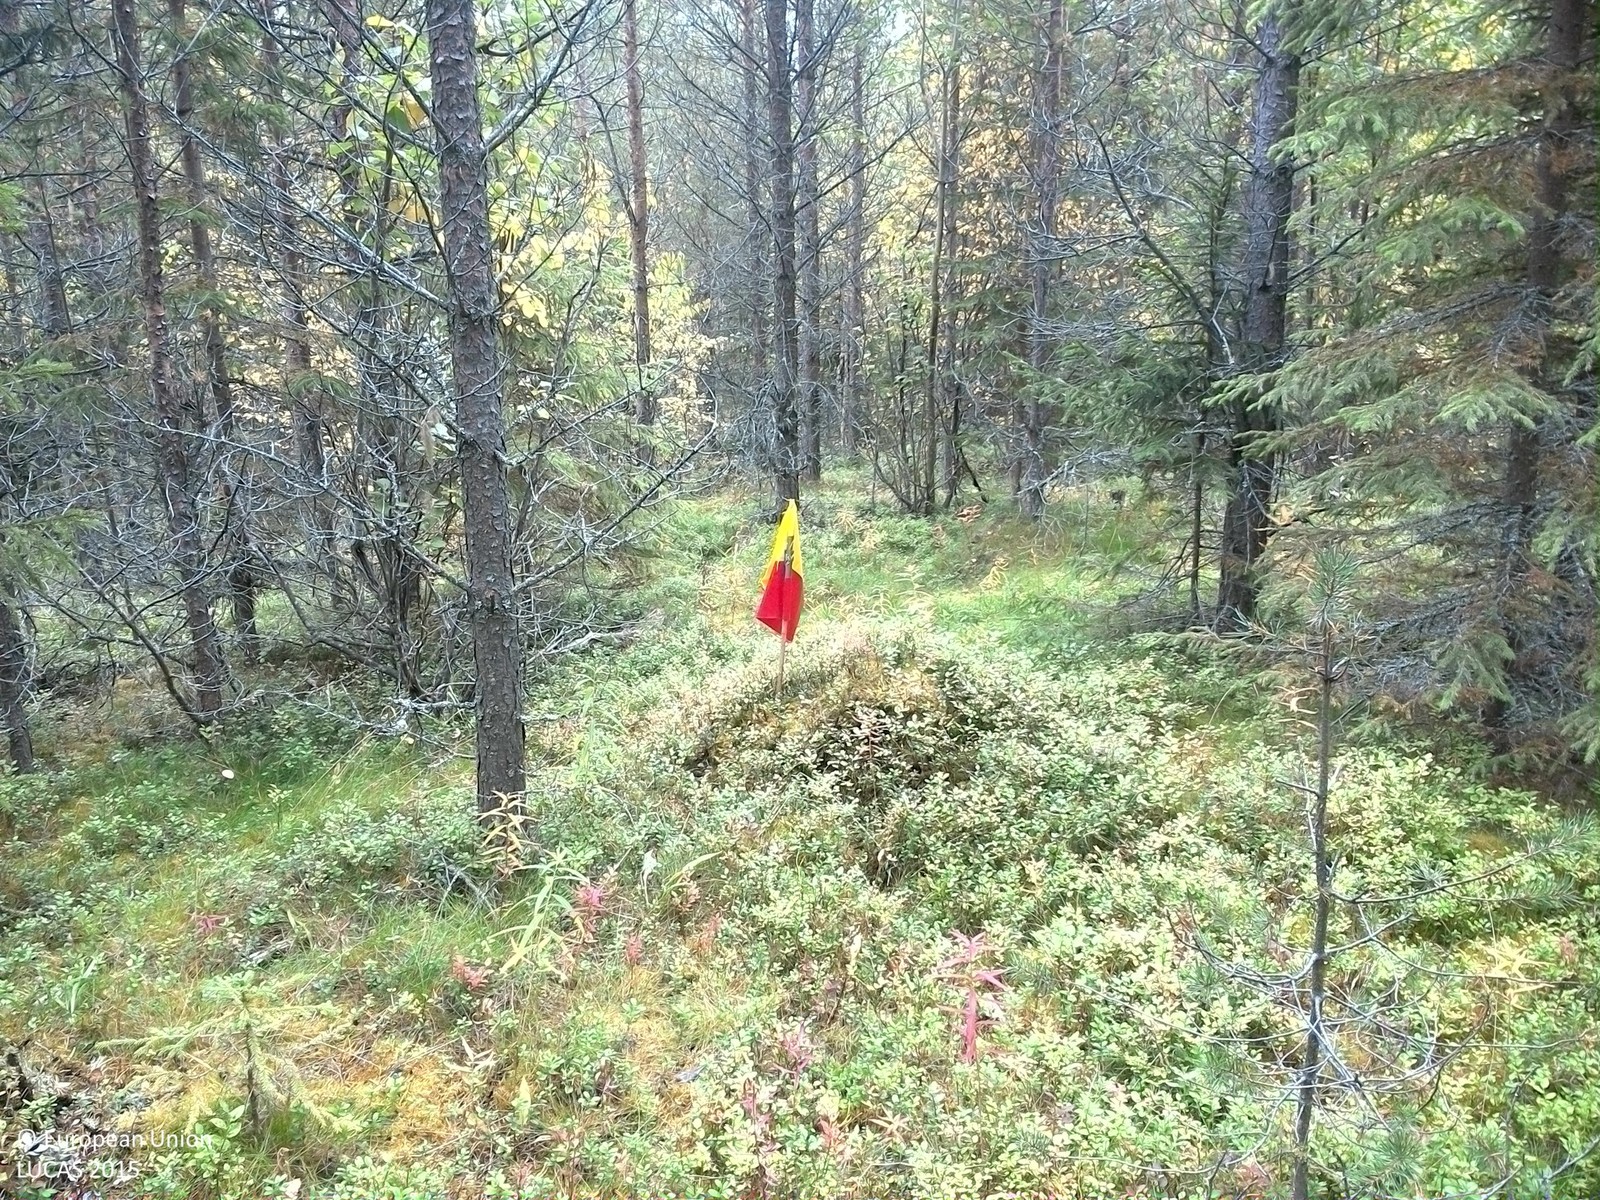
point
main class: Woodland
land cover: Pine dominated mixed woodland
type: boreal forest
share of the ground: 50 - 75 %
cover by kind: coniferous forest trees 45 %, shrubs 25 %, broadleaved forest trees 15 %, lichens and mosses 10 %, herbaceous plants 5 %
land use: Forestry
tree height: > 5 m
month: September
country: SE
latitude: 63.6067
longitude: 16.2038
